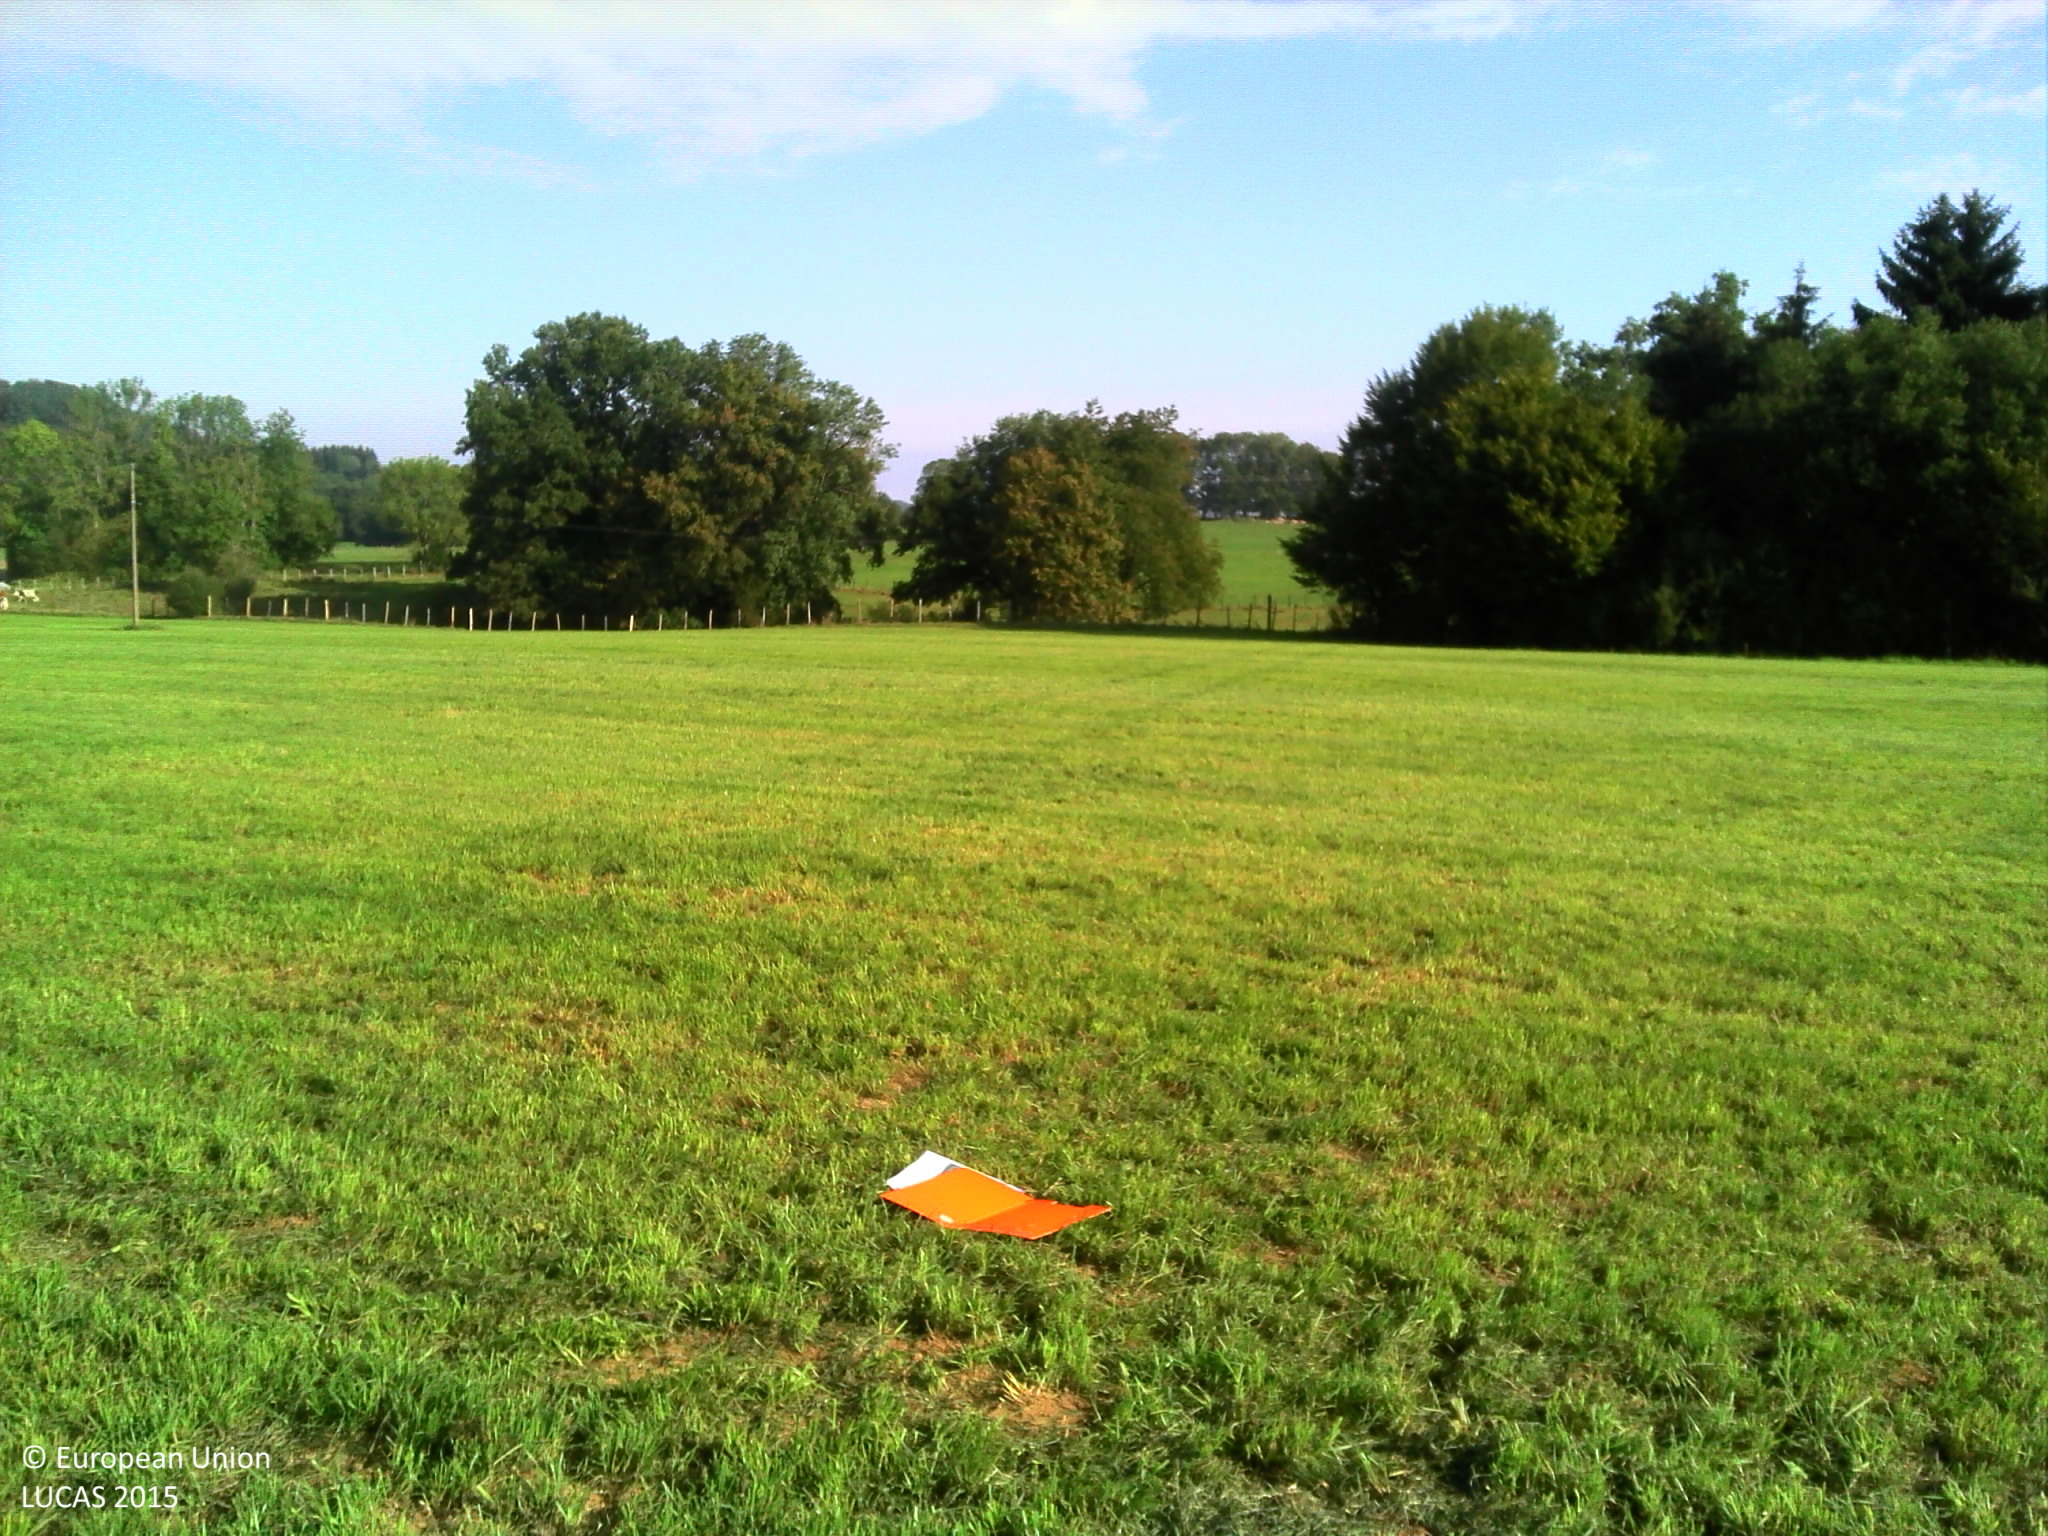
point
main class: Grassland
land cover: Grassland without tree/shrub cover
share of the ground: > 75 %
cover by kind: herbaceous plants 100 %
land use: Agriculture (excluding fallow land and kitchen gardens)
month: September
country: FR
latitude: 47.2261
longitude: 6.3436
